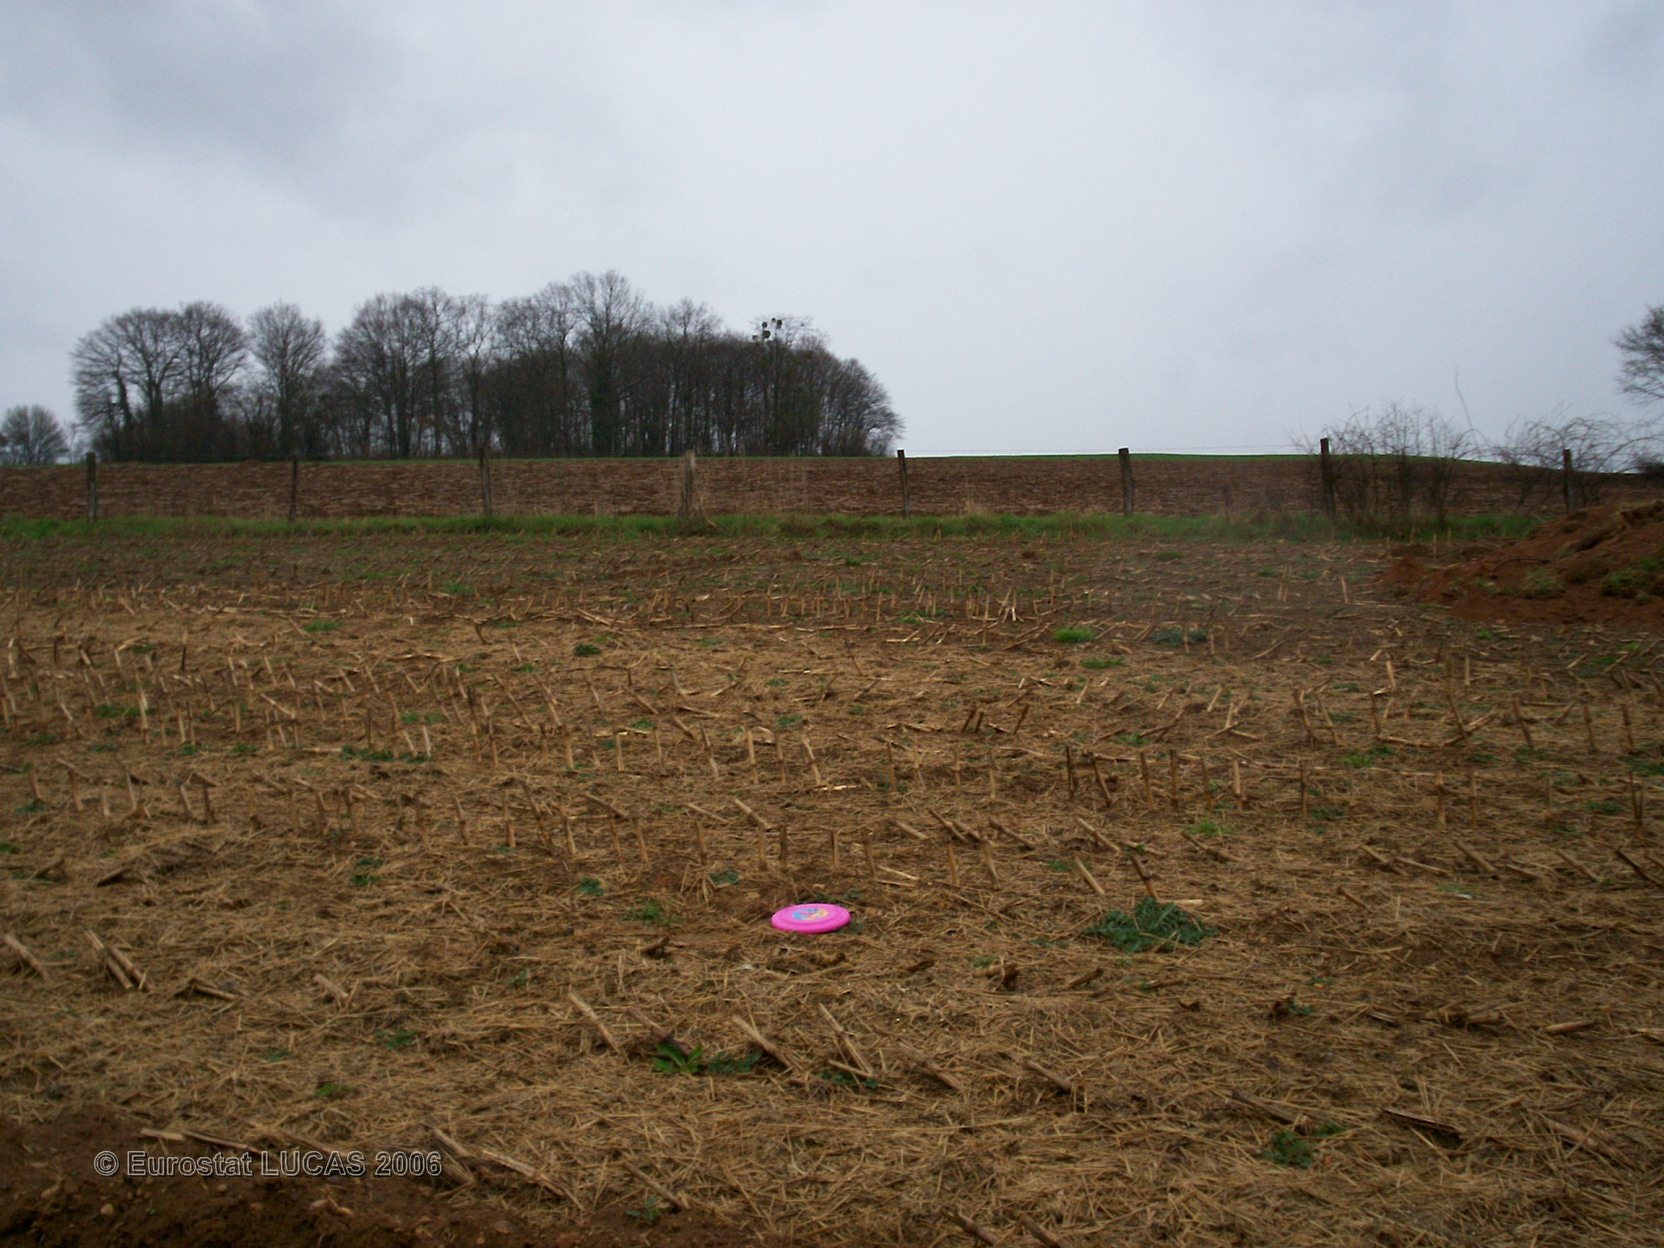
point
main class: Cropland
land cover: Maize
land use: Agriculture (excluding fallow land and kitchen gardens)
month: May
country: FR
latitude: 47.6386
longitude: 6.2878
